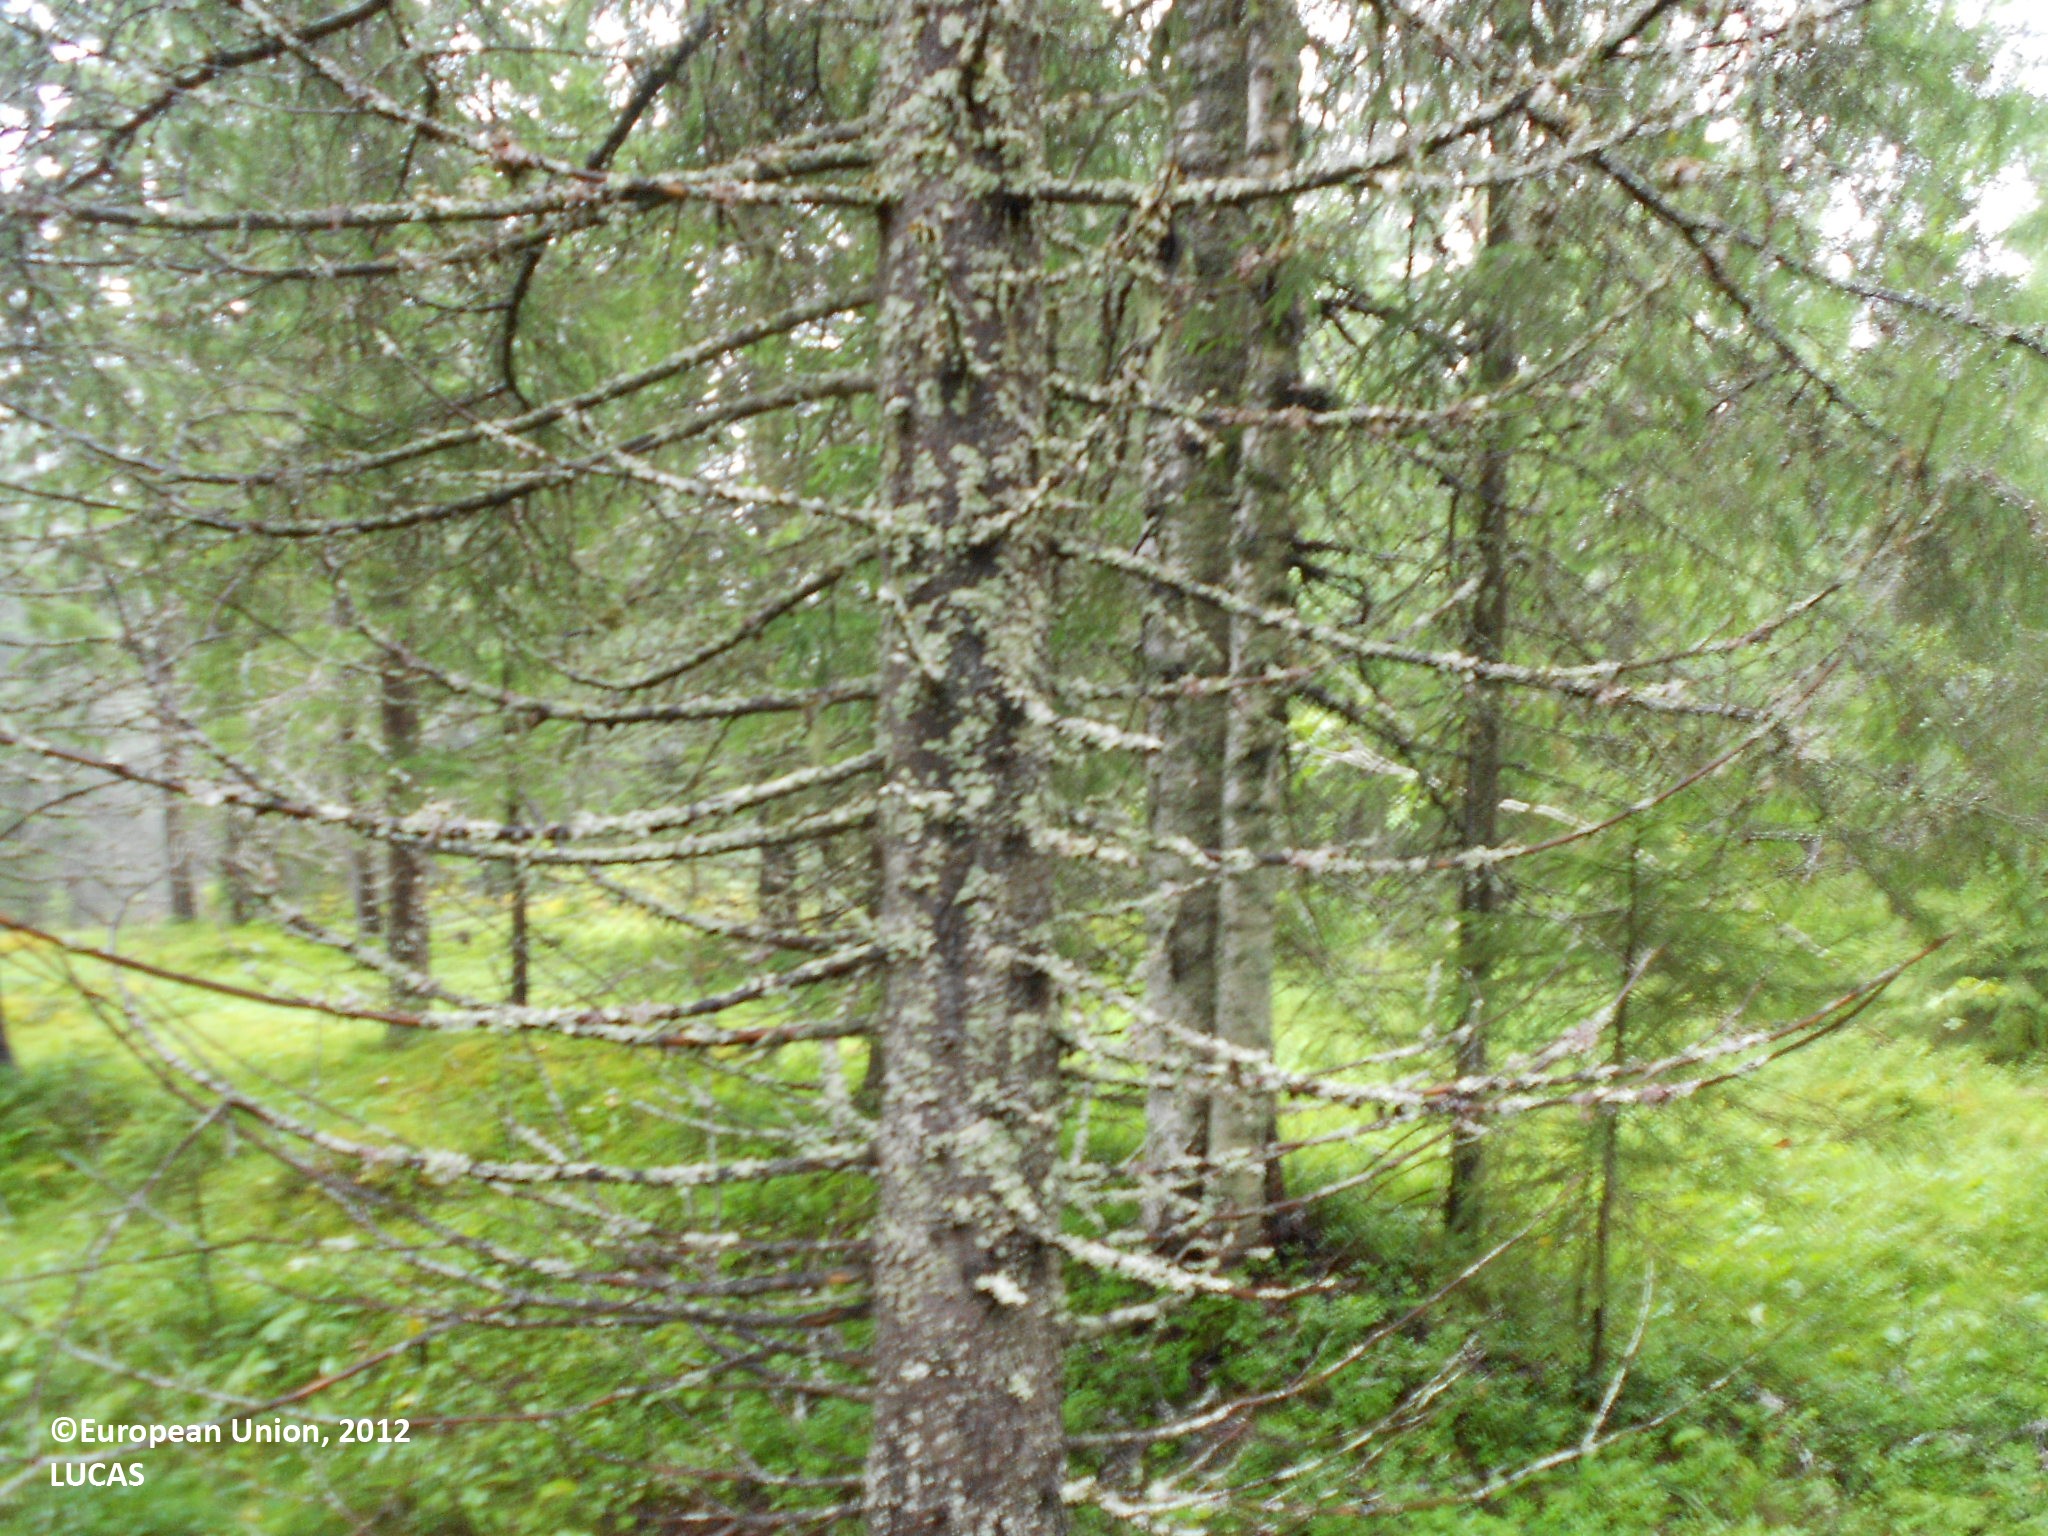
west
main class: Woodland
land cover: Spruce dominated coniferous woodland
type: boreal forest
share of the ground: 50 - 75 %
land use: Forestry
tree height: > 5 m
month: August
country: FI
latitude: 63.8984
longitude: 28.2874
